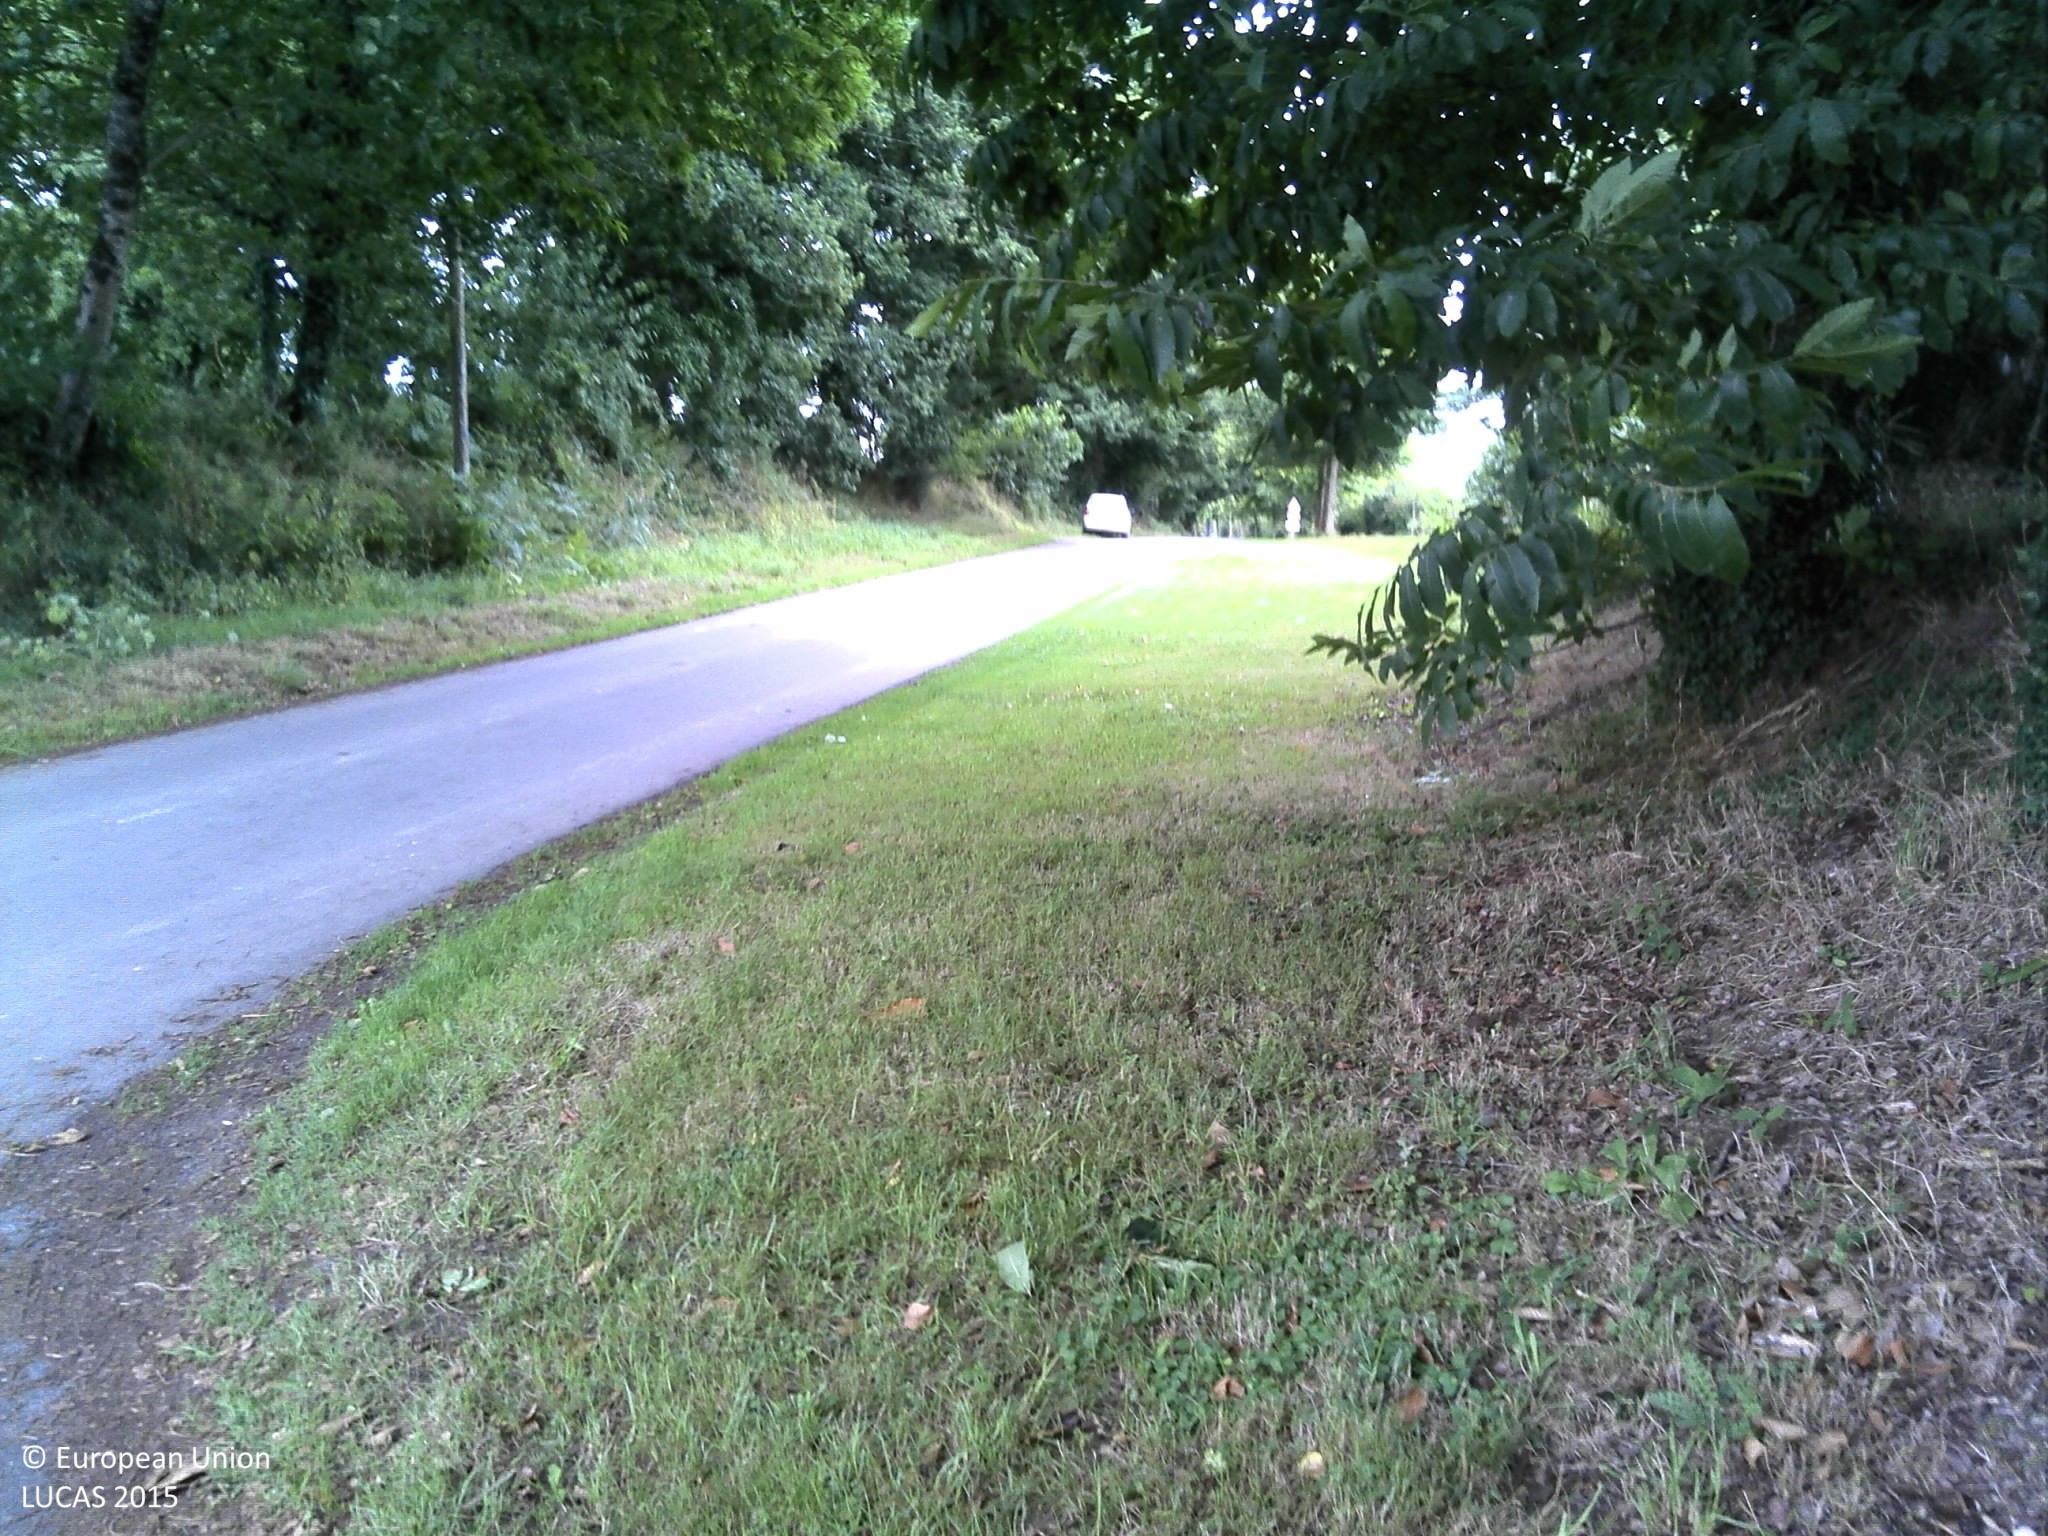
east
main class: Grassland
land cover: Grassland without tree/shrub cover
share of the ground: > 75 %
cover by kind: herbaceous plants 100 %
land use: Residential
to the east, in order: Grassland without tree/shrub cover; Paved roads, cycling and walking lanes; Grassland with sparse tree/shrub cover; Managed hedges; Grassland with sparse tree/shrub cover; Managed hedges; Grassland without tree/shrub cover; Artificial constructions in urban areas; Grass margins; Paved roads, cycling and walking lanes; Grass margins; Ditches and canals; Lines of trees; Spontaneously vegetated surfaces
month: July
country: FR
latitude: 48.2707
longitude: -3.5932
